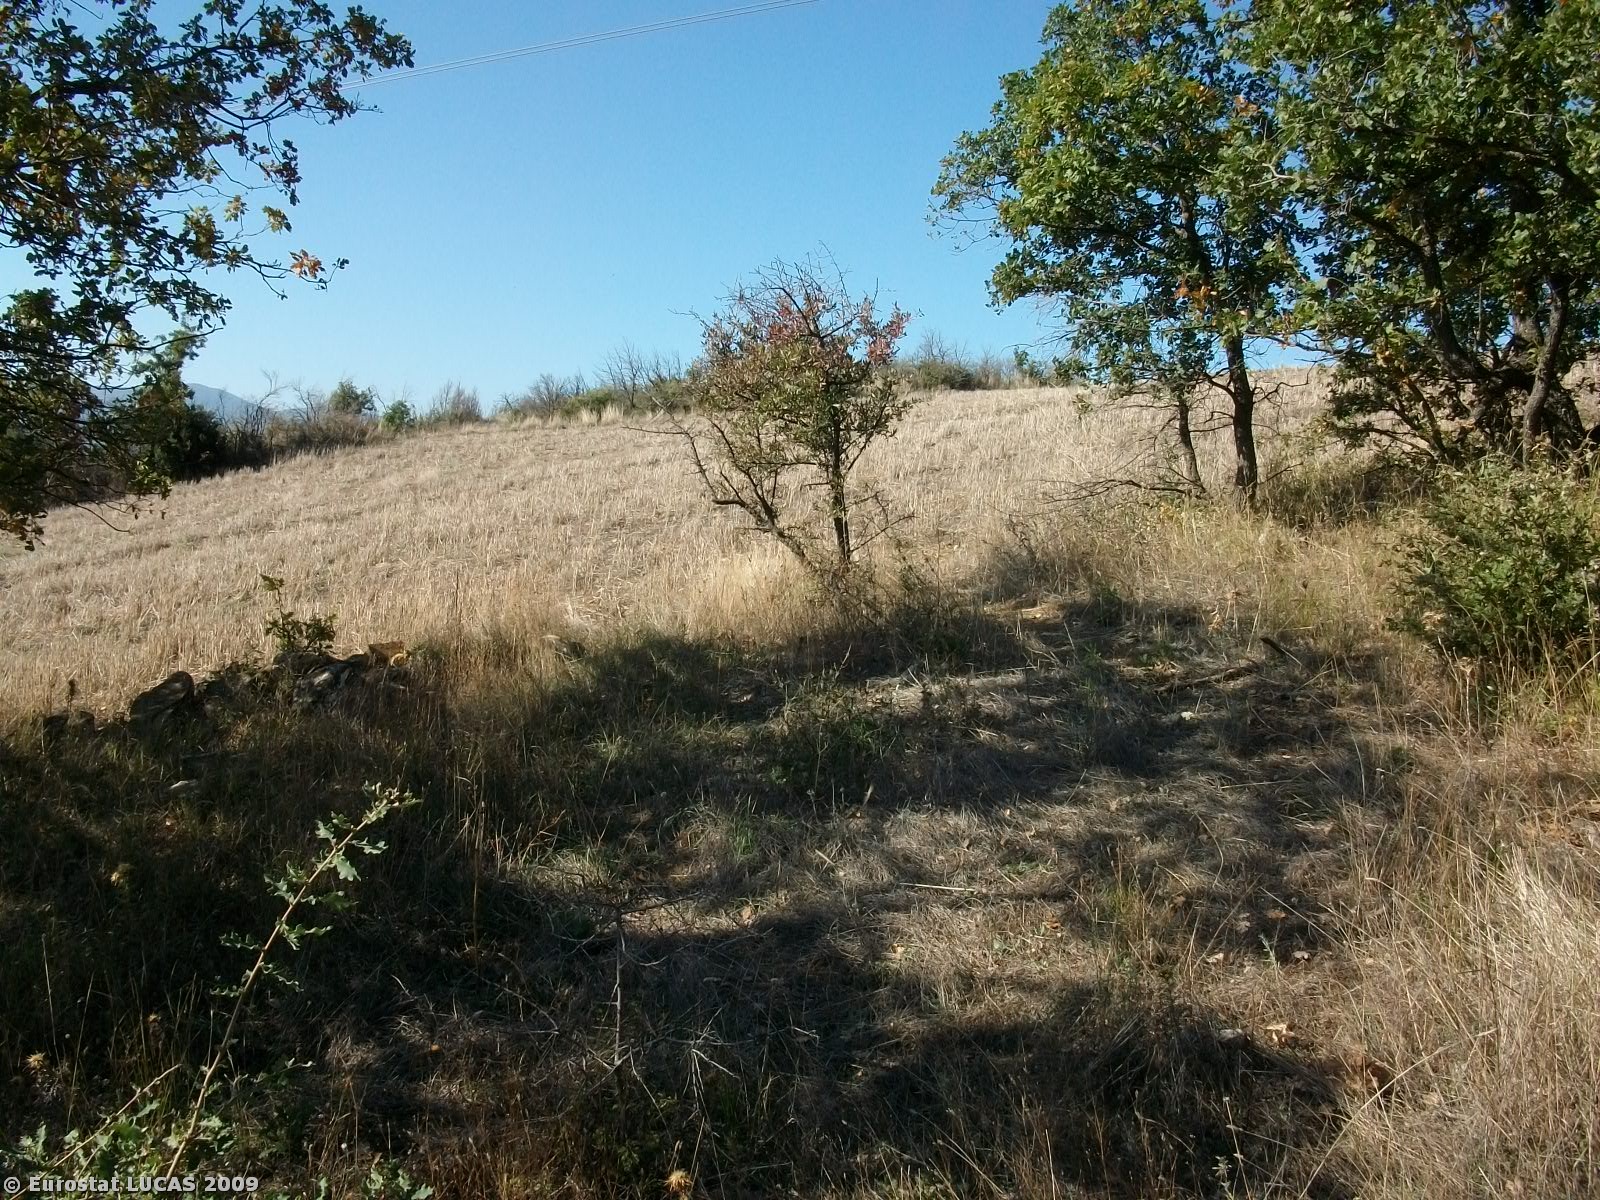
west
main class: Woodland
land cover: Broadleaved woodland
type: thermophilous deciduous forest
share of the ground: 25 - 50 %
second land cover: Grassland with sparse tree/shrub cover
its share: > 75 %
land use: Forestry
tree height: > 5 m
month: October
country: GR
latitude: 39.0829
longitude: 22.4800
